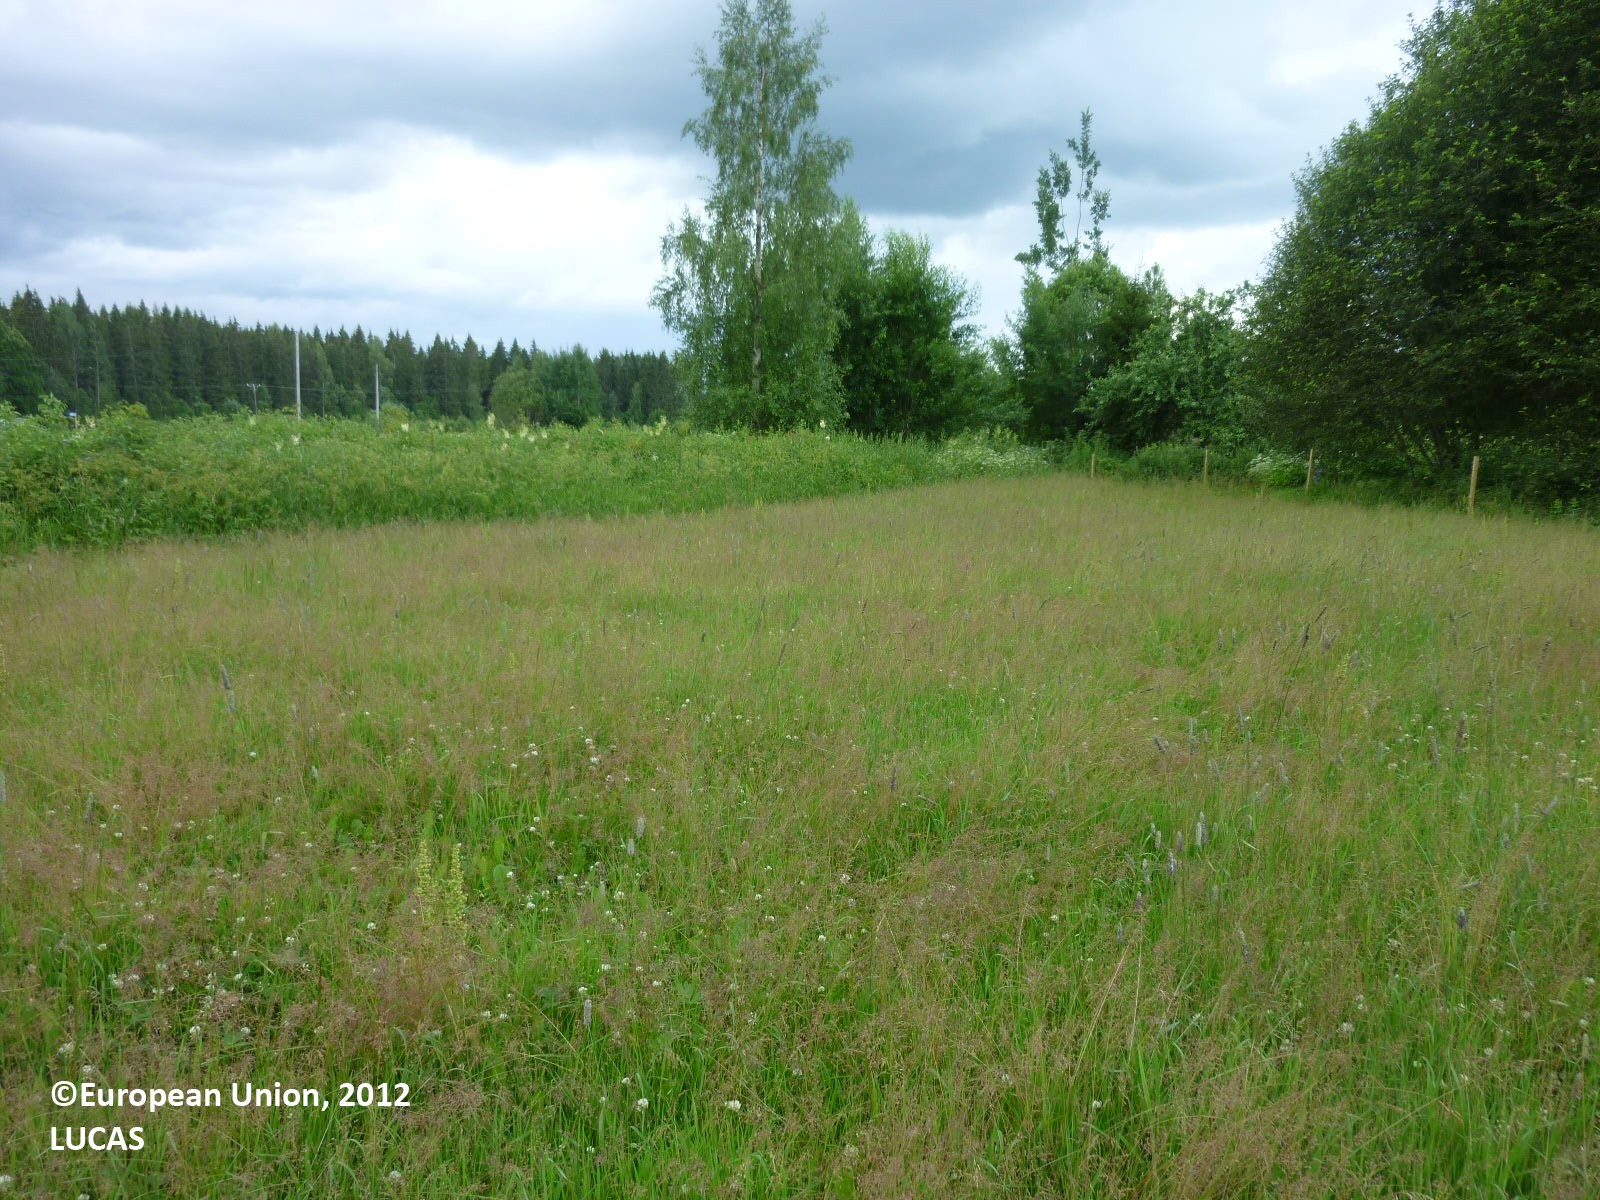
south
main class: Grassland
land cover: Grassland without tree/shrub cover
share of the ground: > 75 %
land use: Agriculture (excluding fallow land and kitchen gardens)
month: July
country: FI
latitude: 61.2679
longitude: 22.0495
